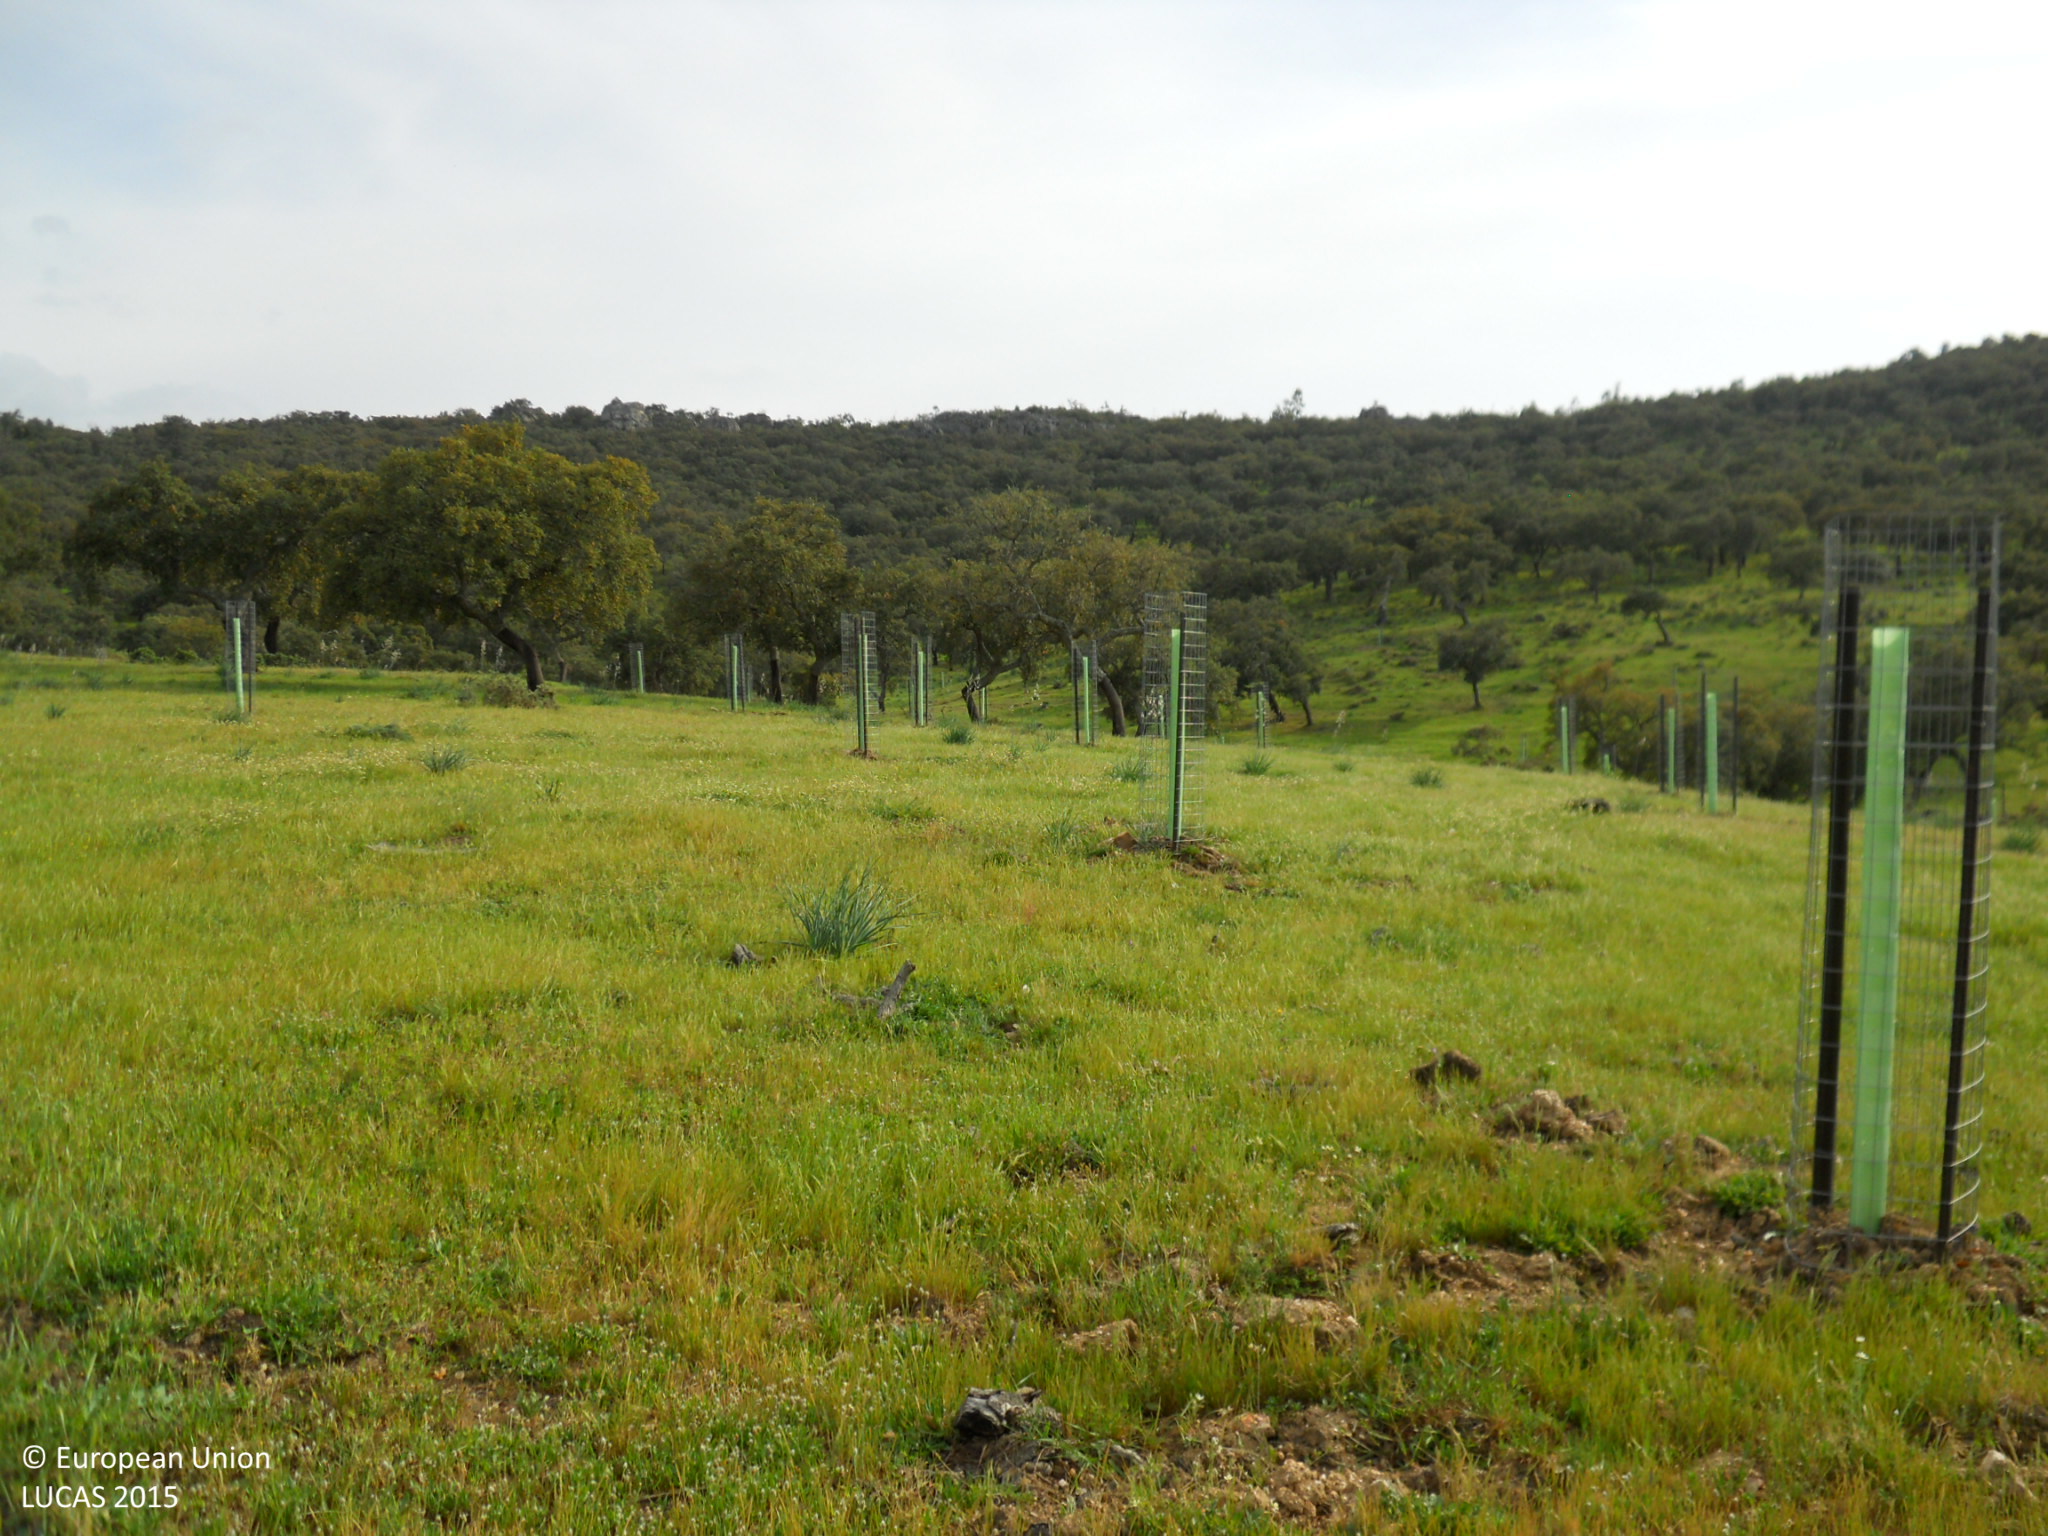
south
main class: Woodland
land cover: Broadleaved woodland
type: broadleaved evergreen forest
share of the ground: 10 - 25 %
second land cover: Grassland without tree/shrub cover
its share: > 75 %
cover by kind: herbaceous plants 80 %, broadleaved forest trees 20 %
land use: Forestry
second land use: Agriculture (excluding fallow land and kitchen gardens)
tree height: > 5 m
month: April
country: ES
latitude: 39.1979
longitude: -6.5672
